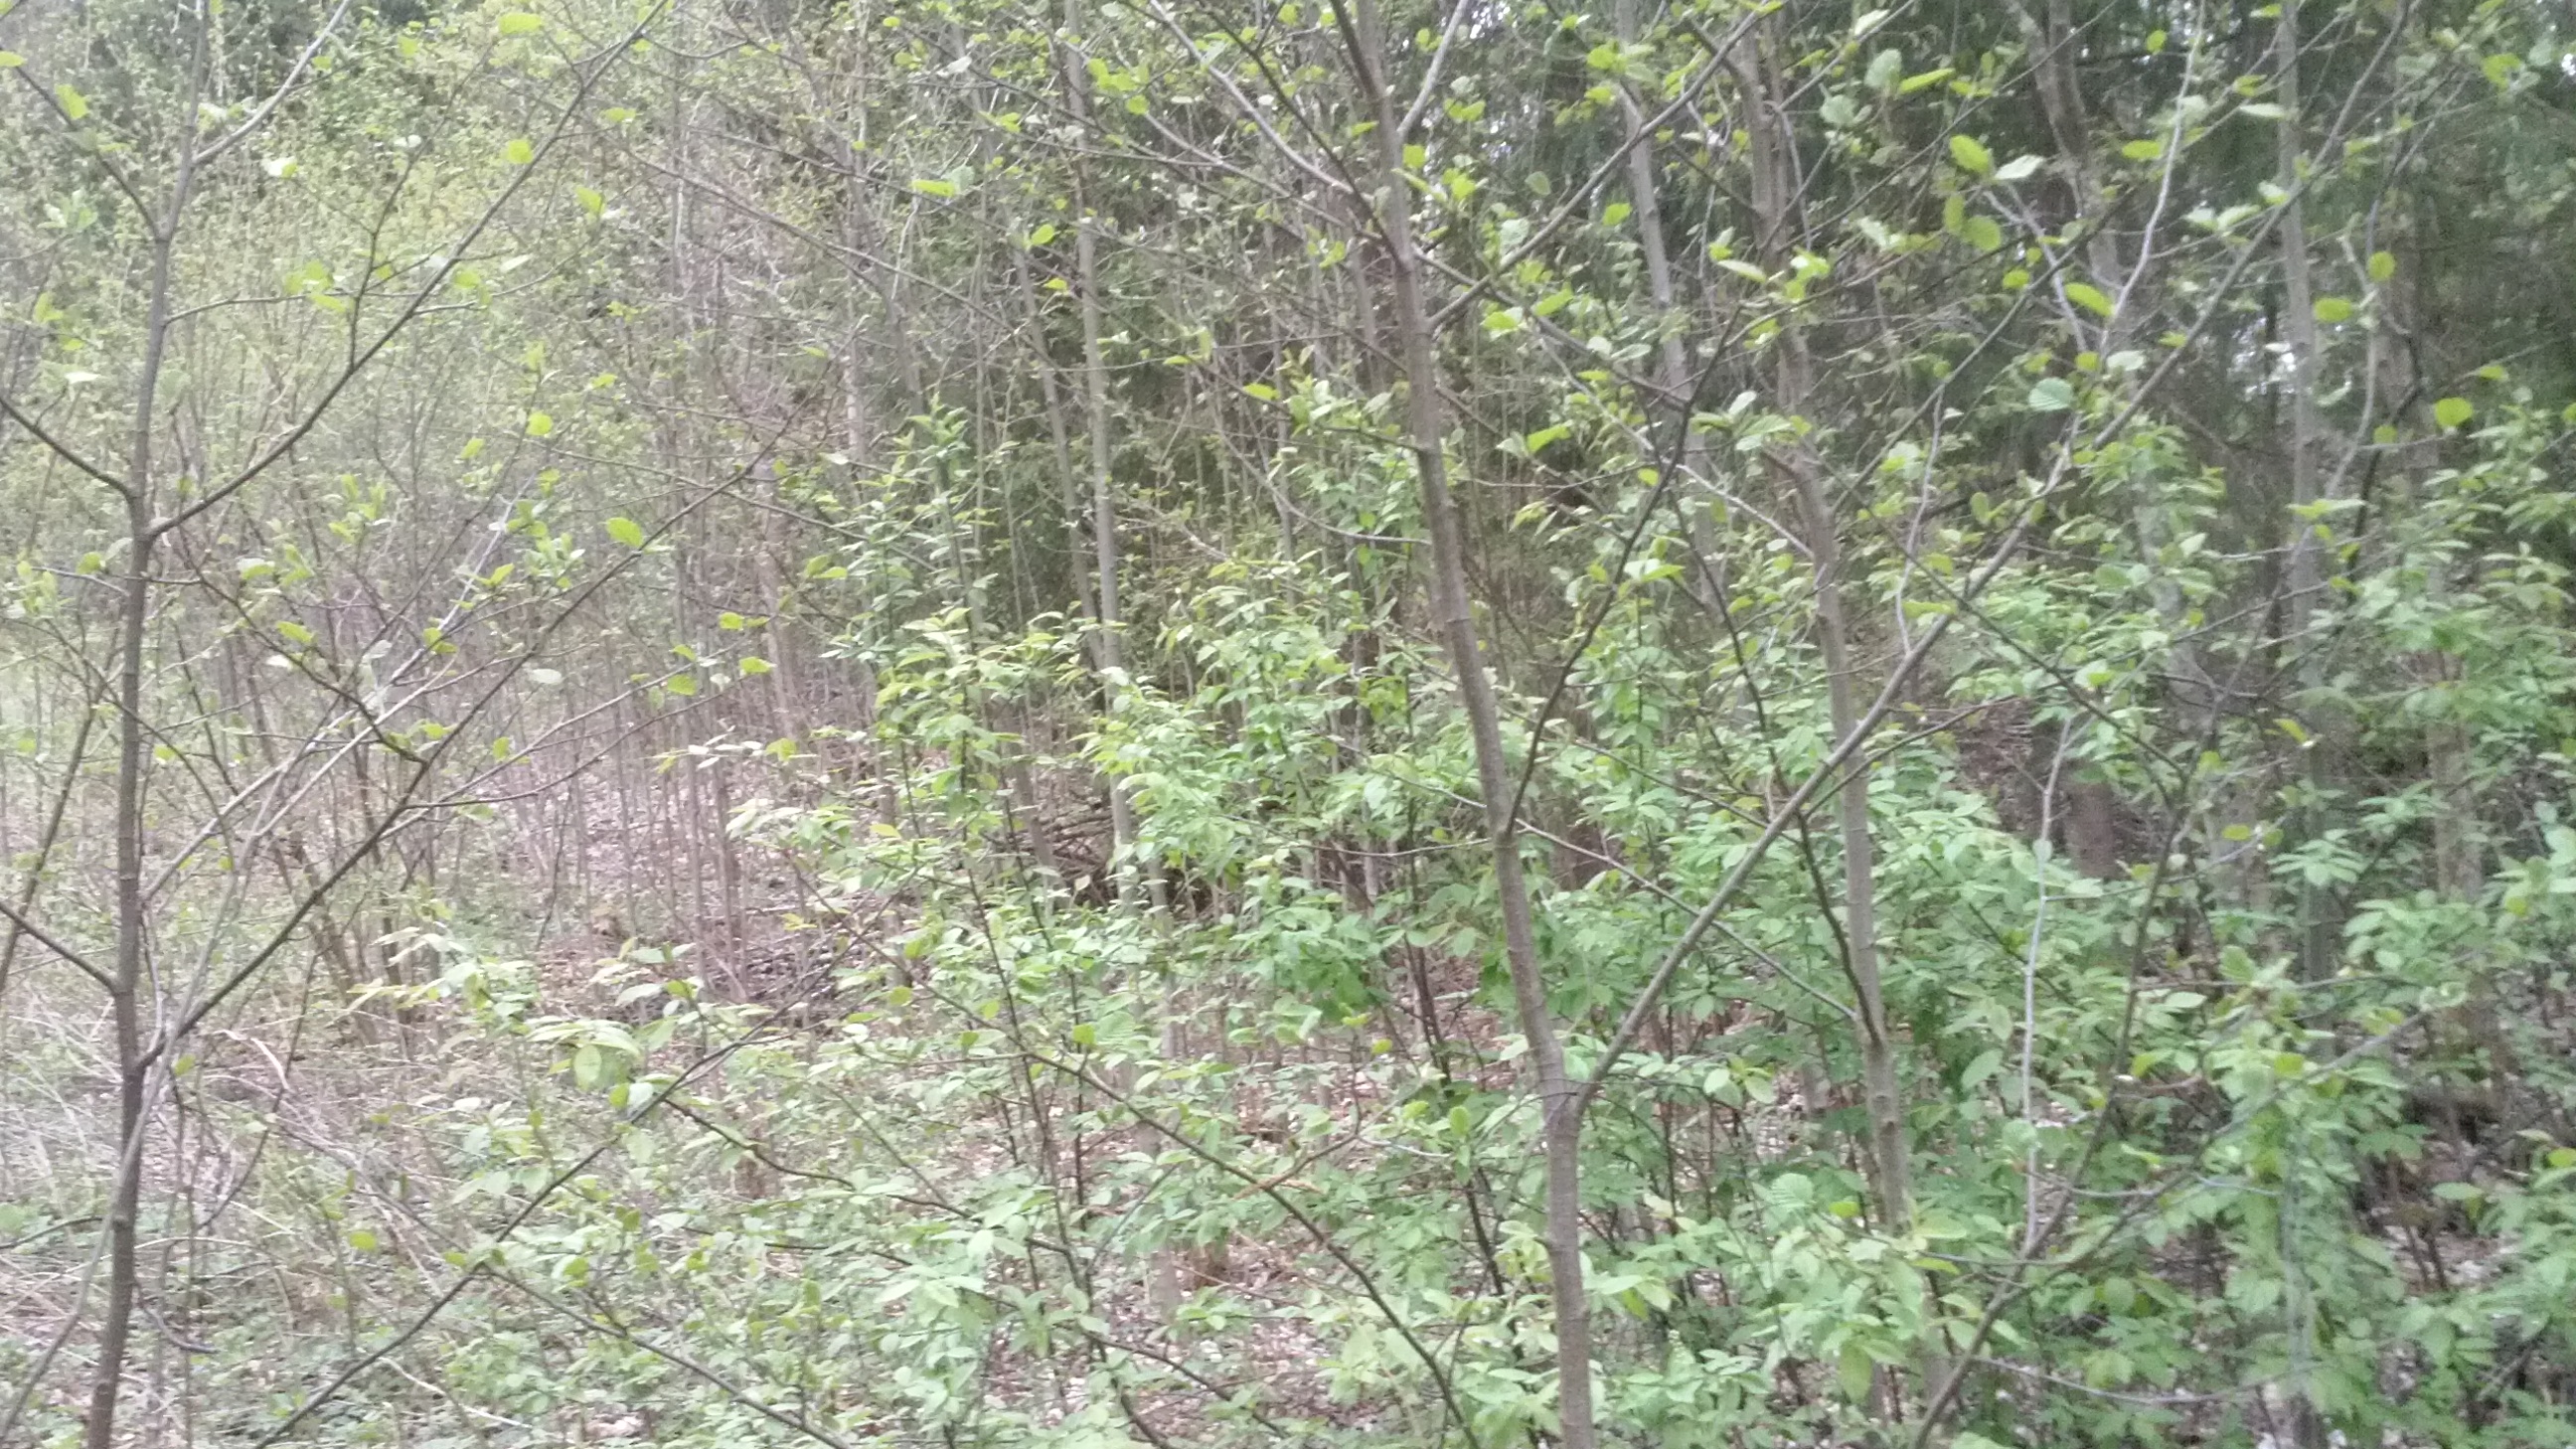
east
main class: Woodland
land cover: Spruce dominated mixed woodland
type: hemiboreal forest and nemoral coniferous forest and mixed broadleaved-coniferous forest
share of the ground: > 75 %
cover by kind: coniferous forest trees 60 %, broadleaved forest trees 40 %
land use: Forestry
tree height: < 5 m
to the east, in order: Spruce dominated mixed woodland; Grassland without tree/shrub cover; Abandoned hedges; Rivers and streams; Abandoned hedges; Grass margins; Oats; Electric lines; Oats
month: May
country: LV
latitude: 56.0185
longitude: 27.1261
